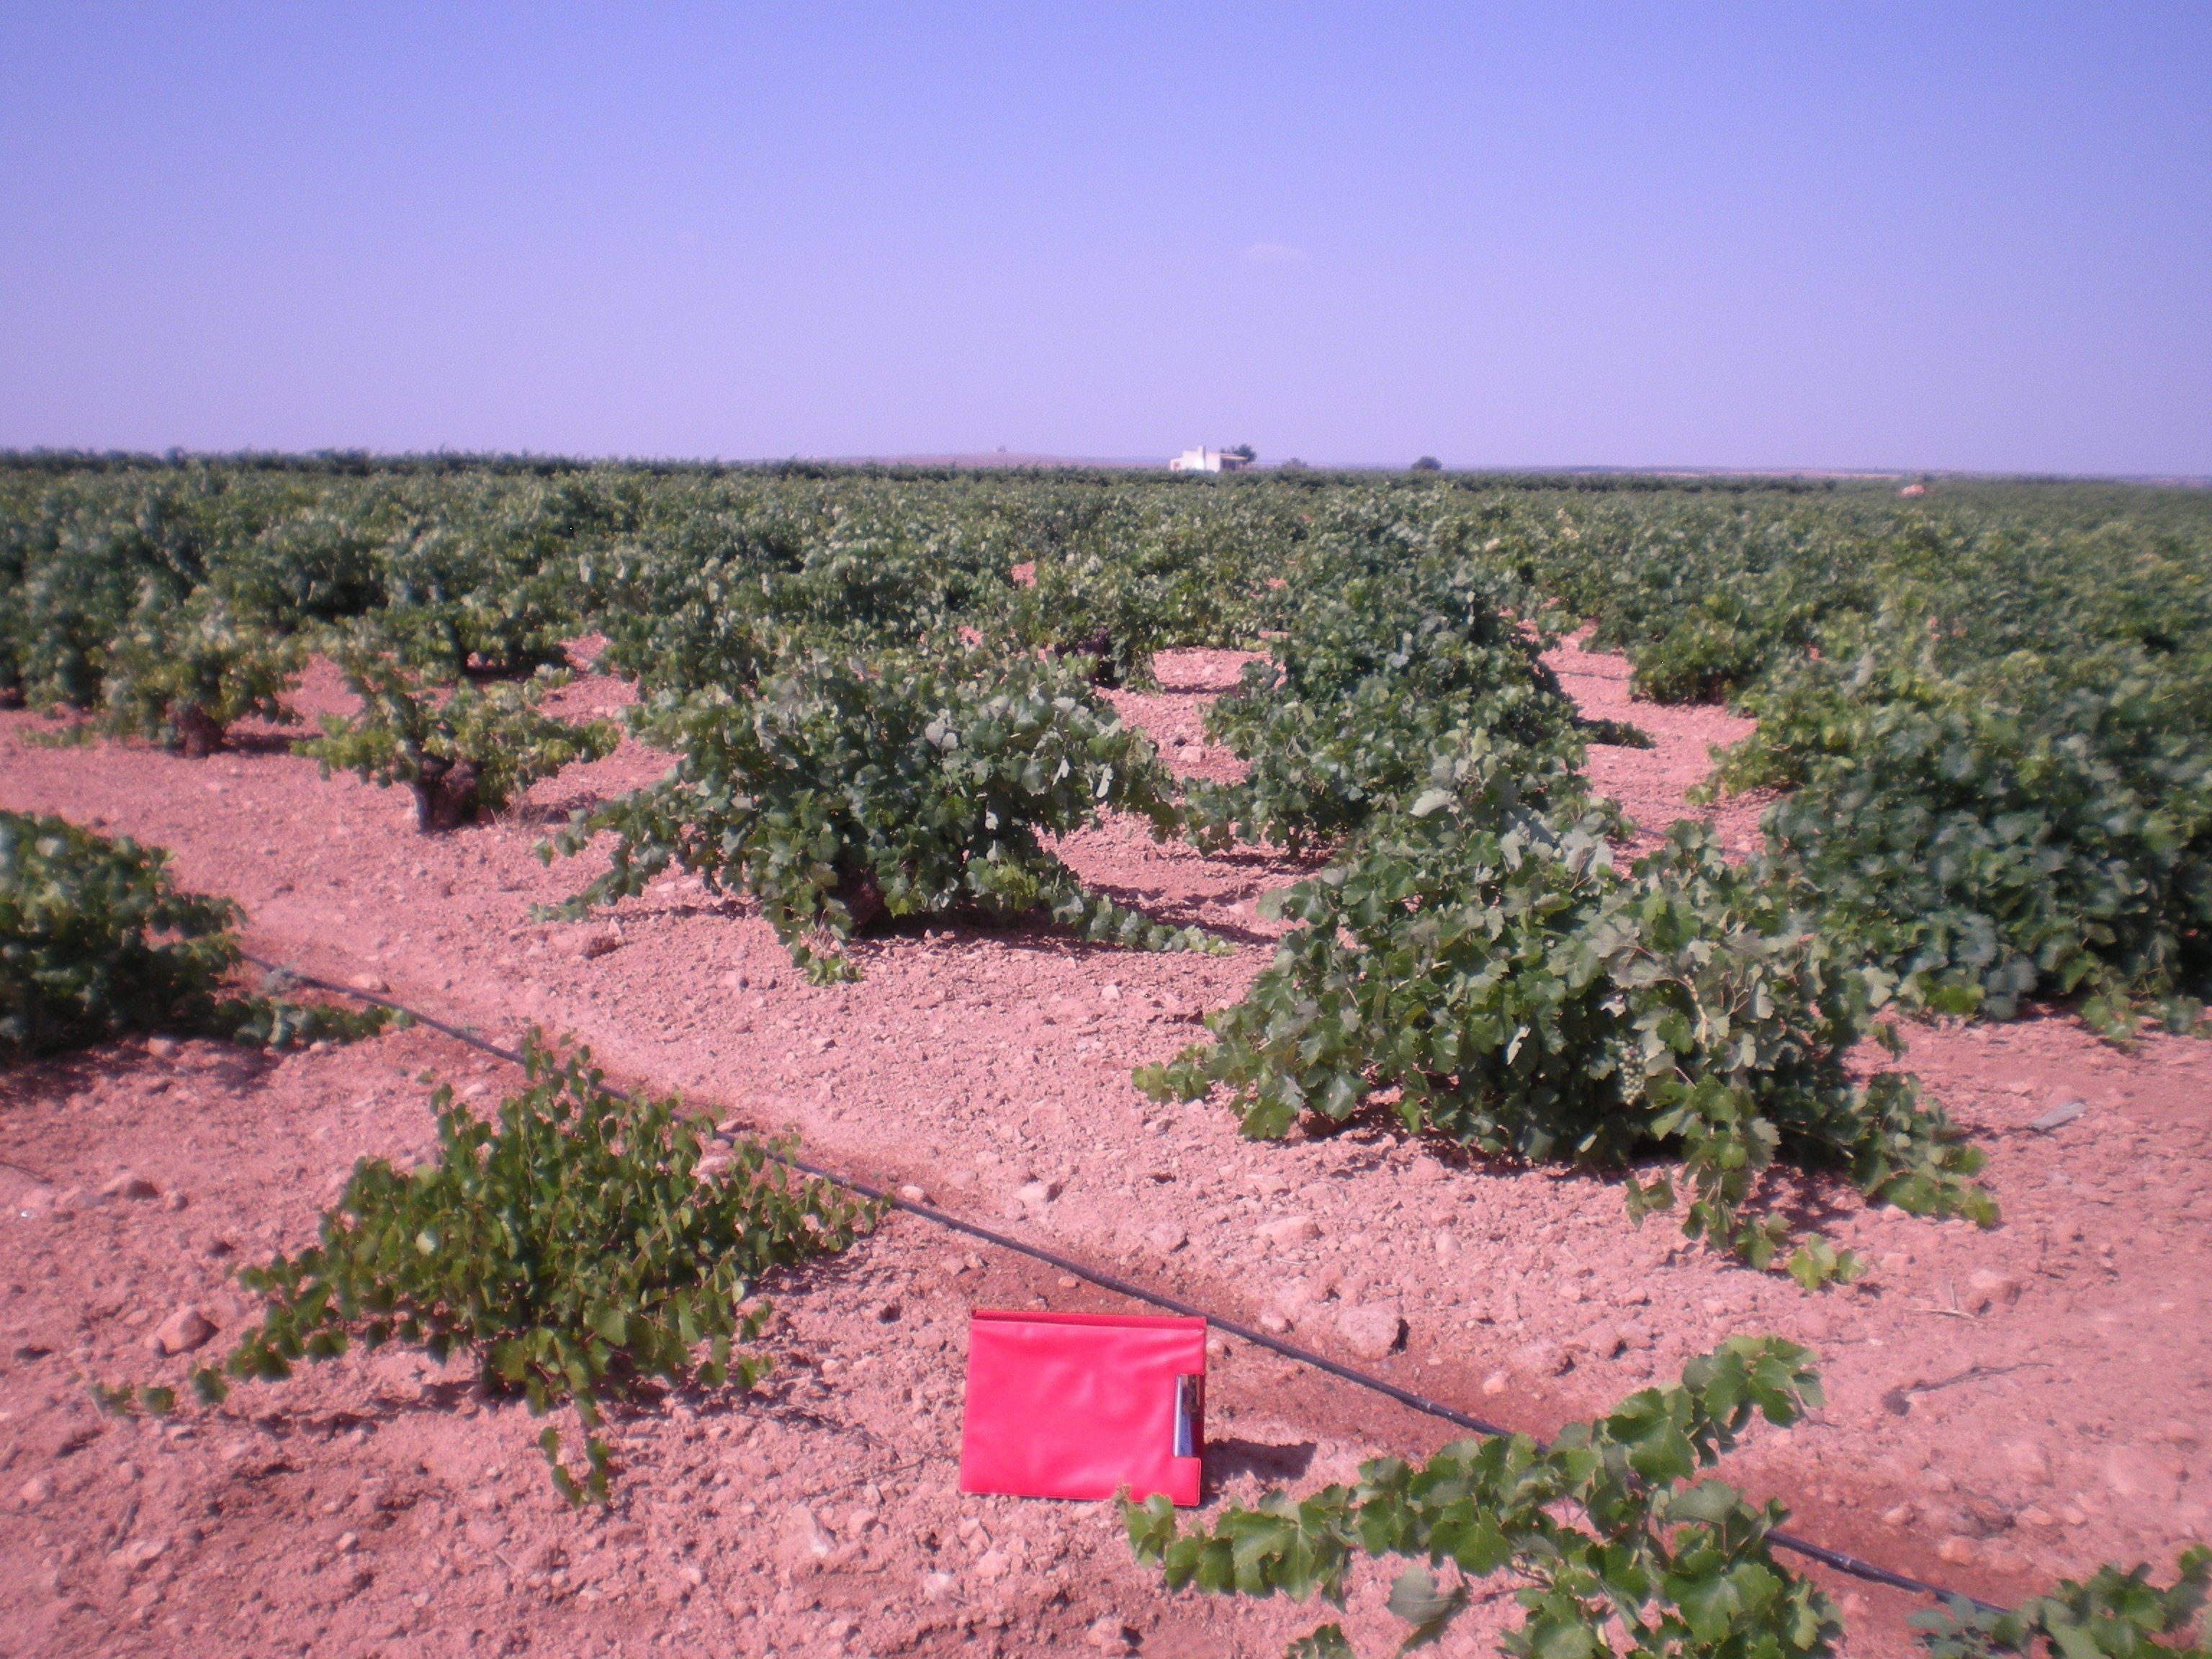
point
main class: Cropland
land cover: Vineyards
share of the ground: 25 - 50 %
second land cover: Other bare soil
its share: > 75 %
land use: Agriculture (excluding fallow land and kitchen gardens)
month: July
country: ES
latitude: 39.4296
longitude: -3.0395
